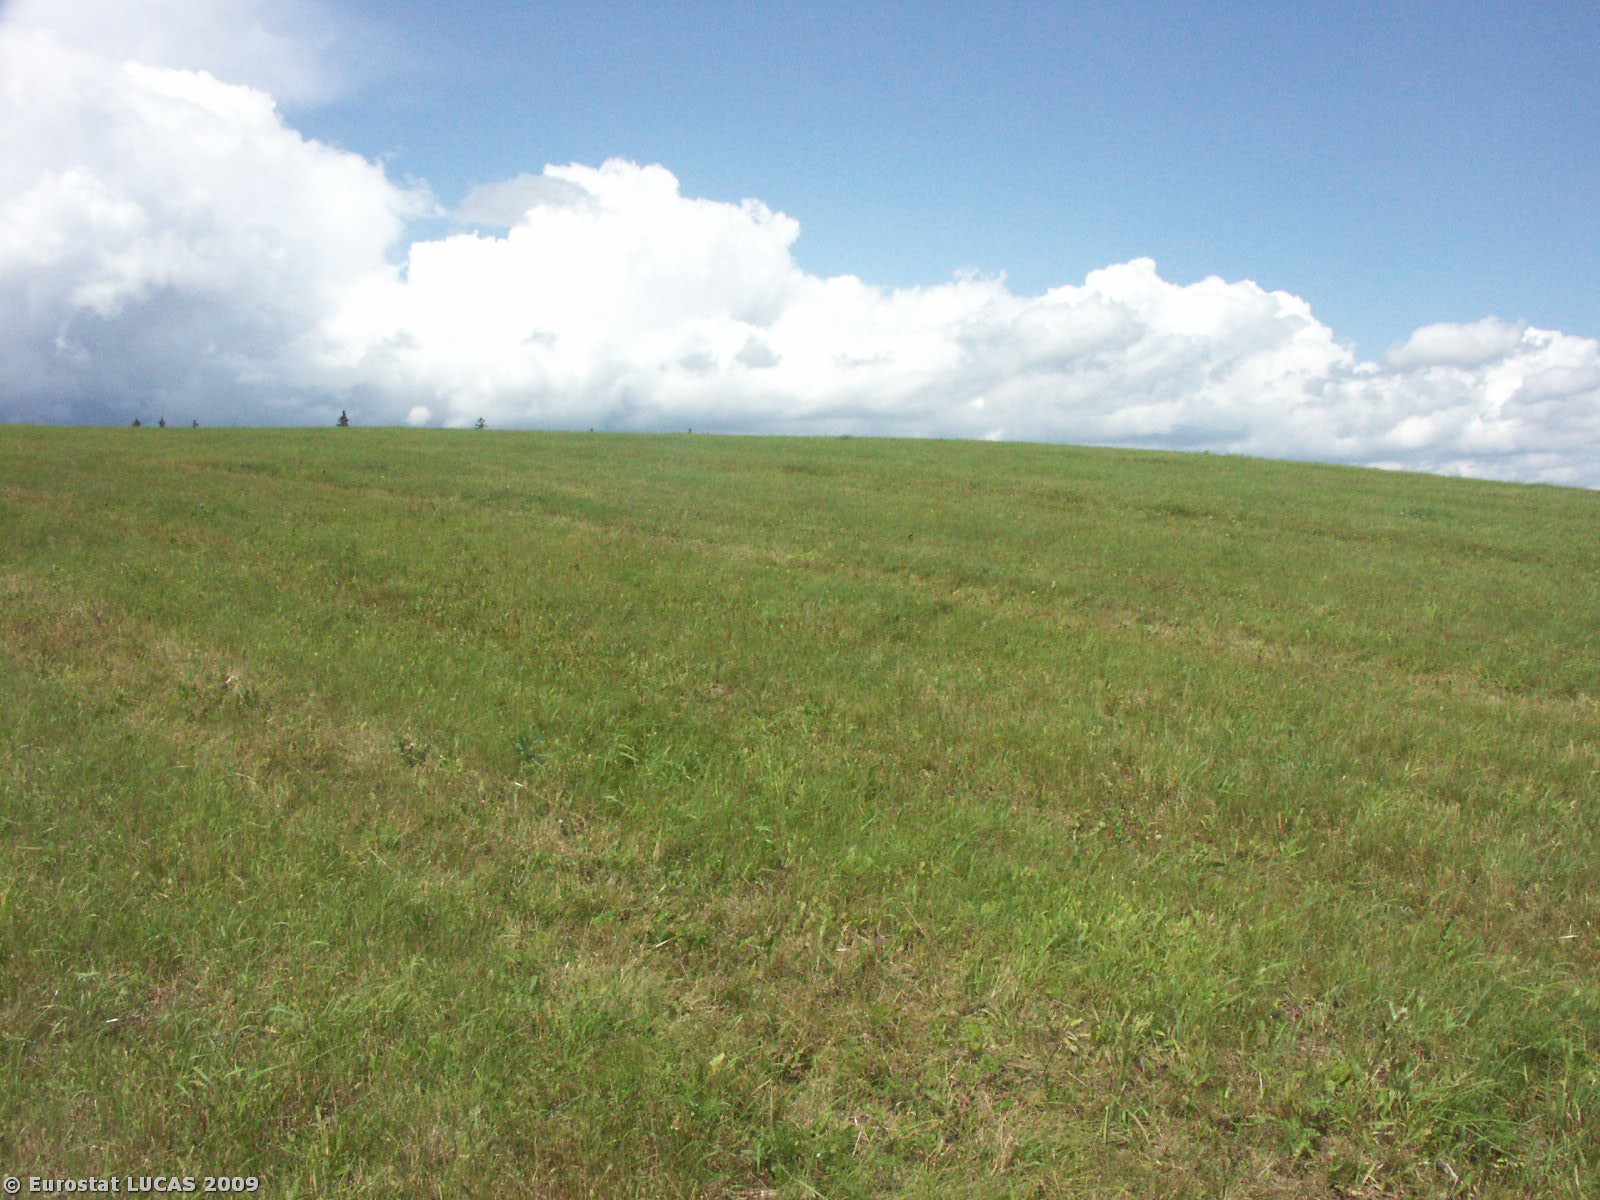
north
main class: Grassland
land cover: Grassland without tree/shrub cover
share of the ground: > 75 %
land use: Agriculture (excluding fallow land and kitchen gardens)
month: July
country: CZ
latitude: 49.8392
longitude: 17.3392
